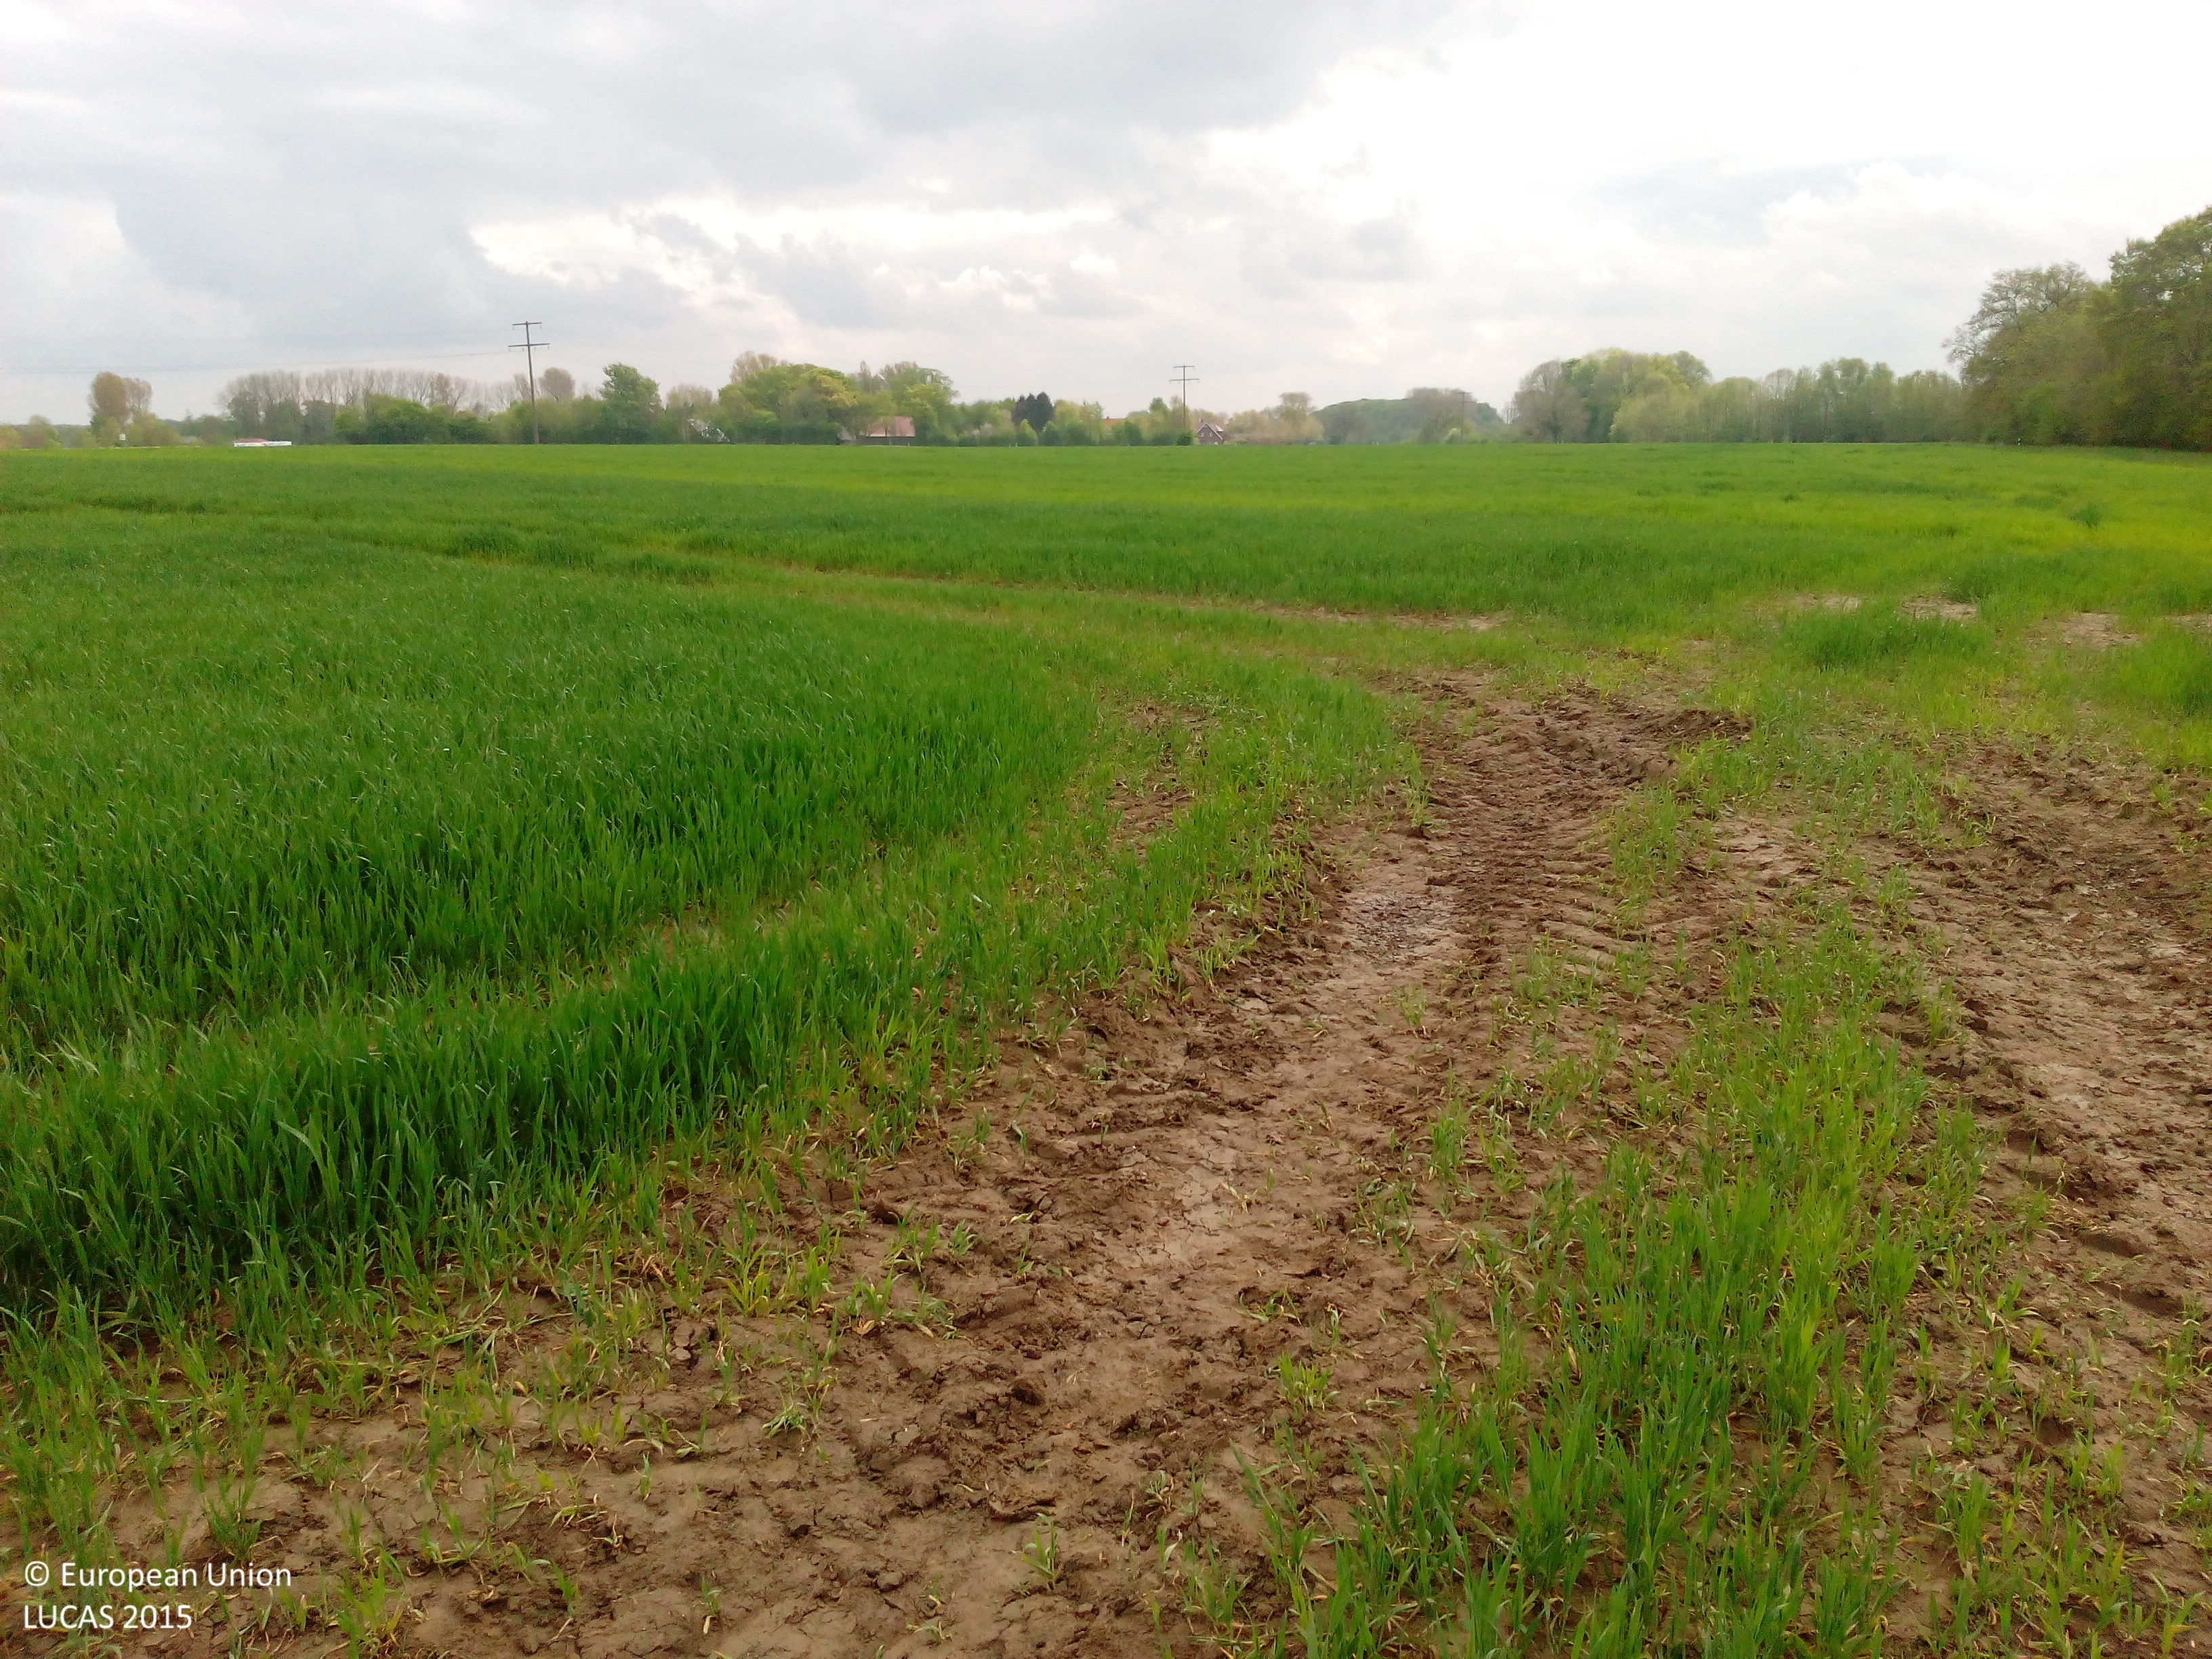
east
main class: Cropland
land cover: Common wheat
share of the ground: > 75 %
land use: Agriculture (excluding fallow land and kitchen gardens)
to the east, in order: Common wheat; Triticale
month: May
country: DE
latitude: 51.9174
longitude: 7.3978
